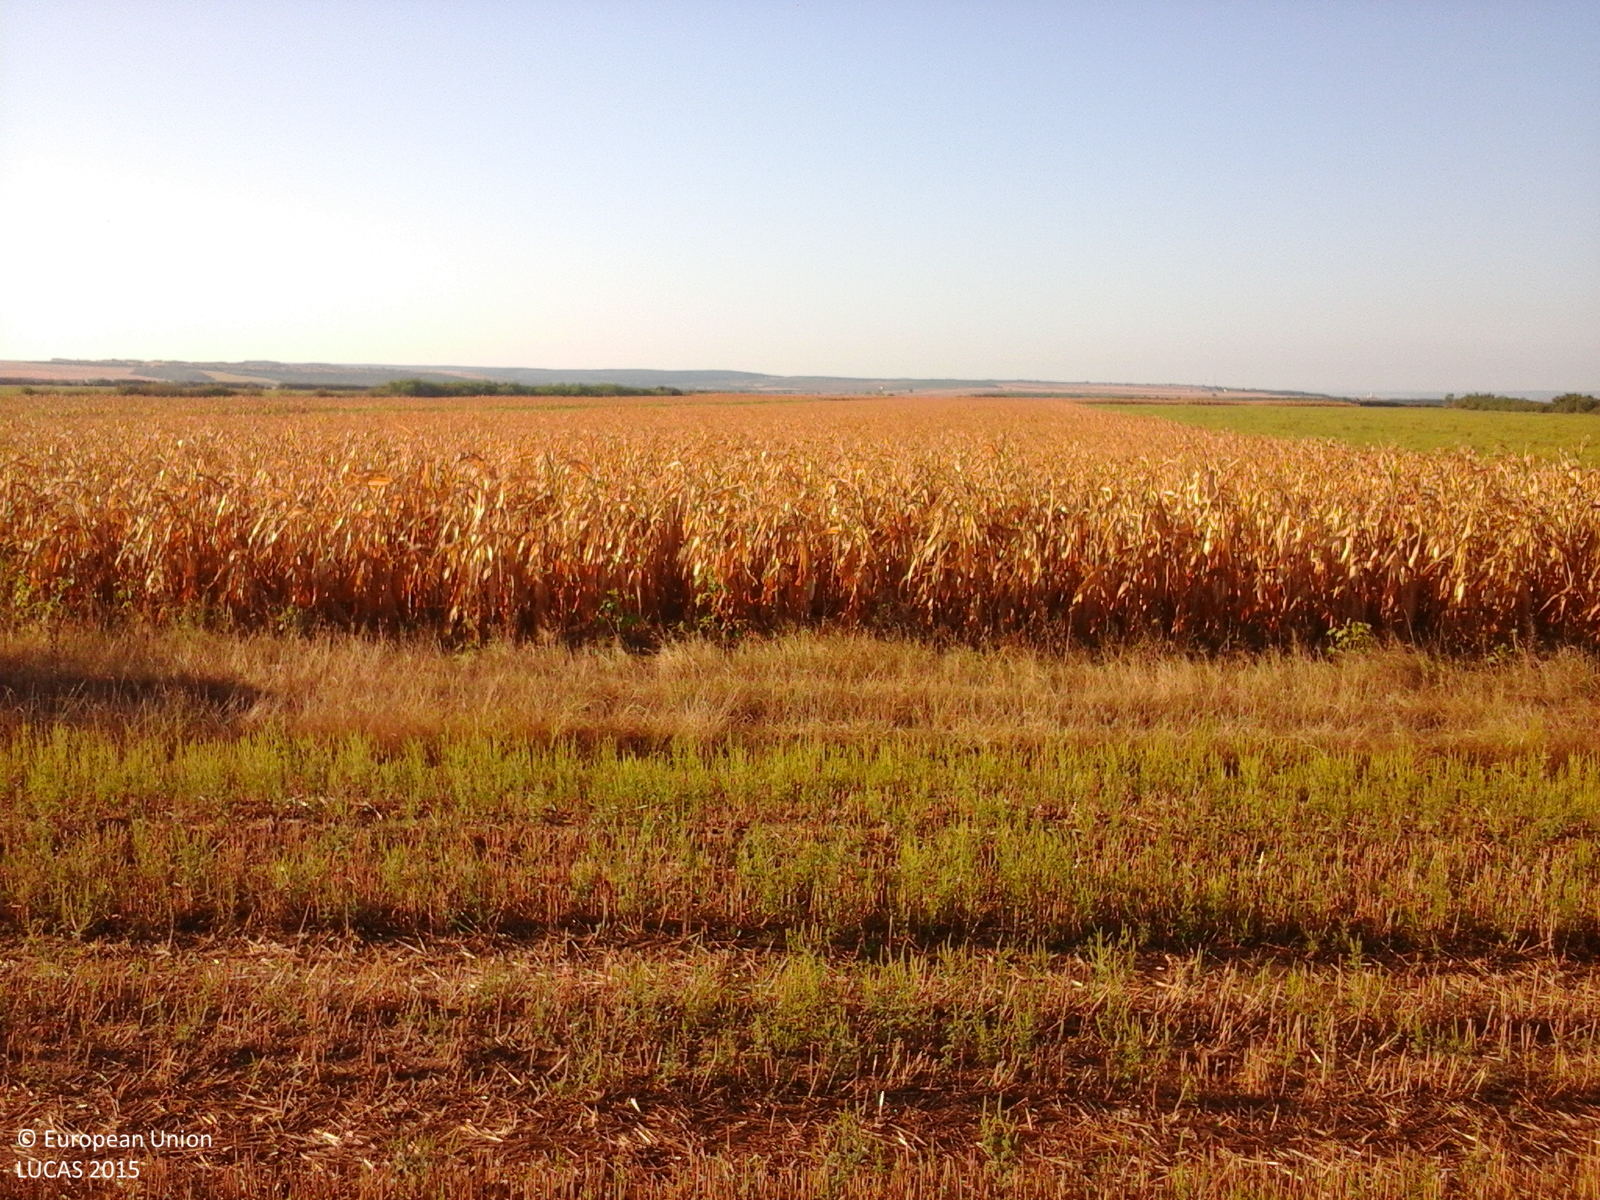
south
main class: Cropland
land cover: Common wheat
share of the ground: > 75 %
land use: Agriculture (excluding fallow land and kitchen gardens)
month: September
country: RO
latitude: 47.5929
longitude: 22.8700
